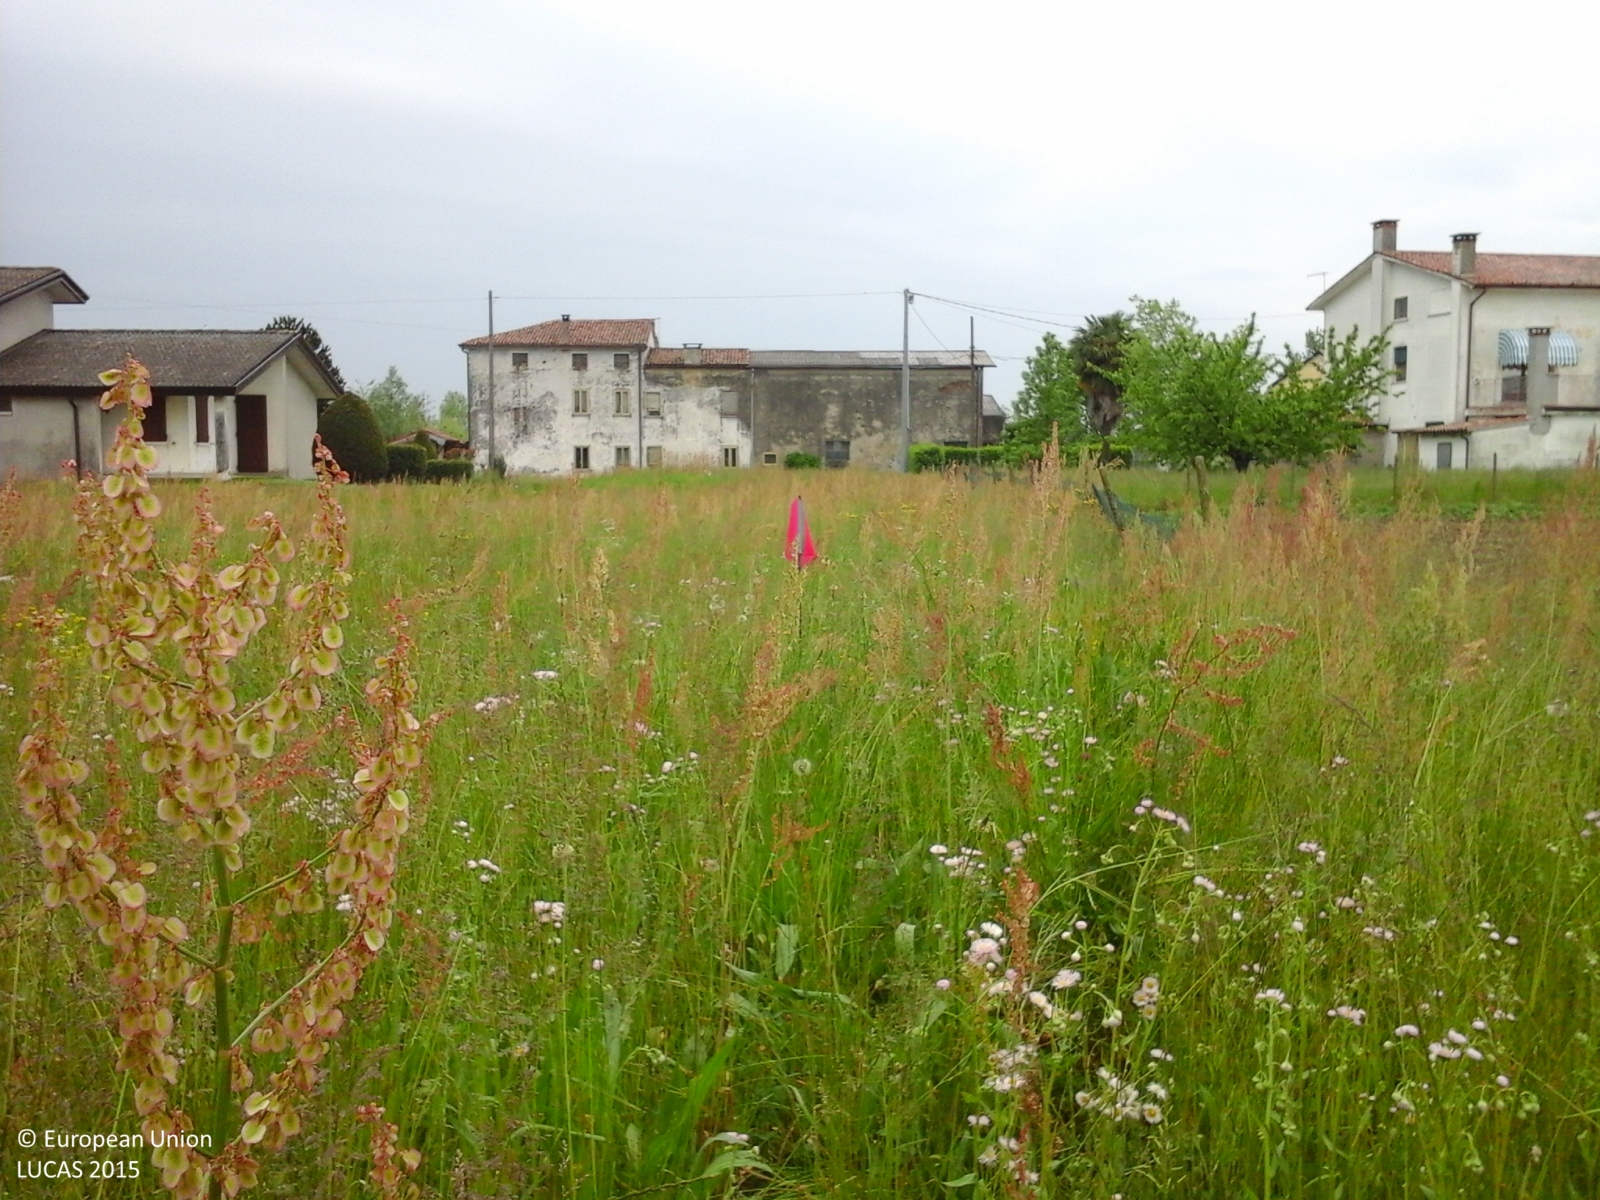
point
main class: Grassland
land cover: Grassland without tree/shrub cover
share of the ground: > 75 %
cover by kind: herbaceous plants 100 %
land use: Agriculture (excluding fallow land and kitchen gardens)
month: May
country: IT
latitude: 45.5448
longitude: 11.7007
